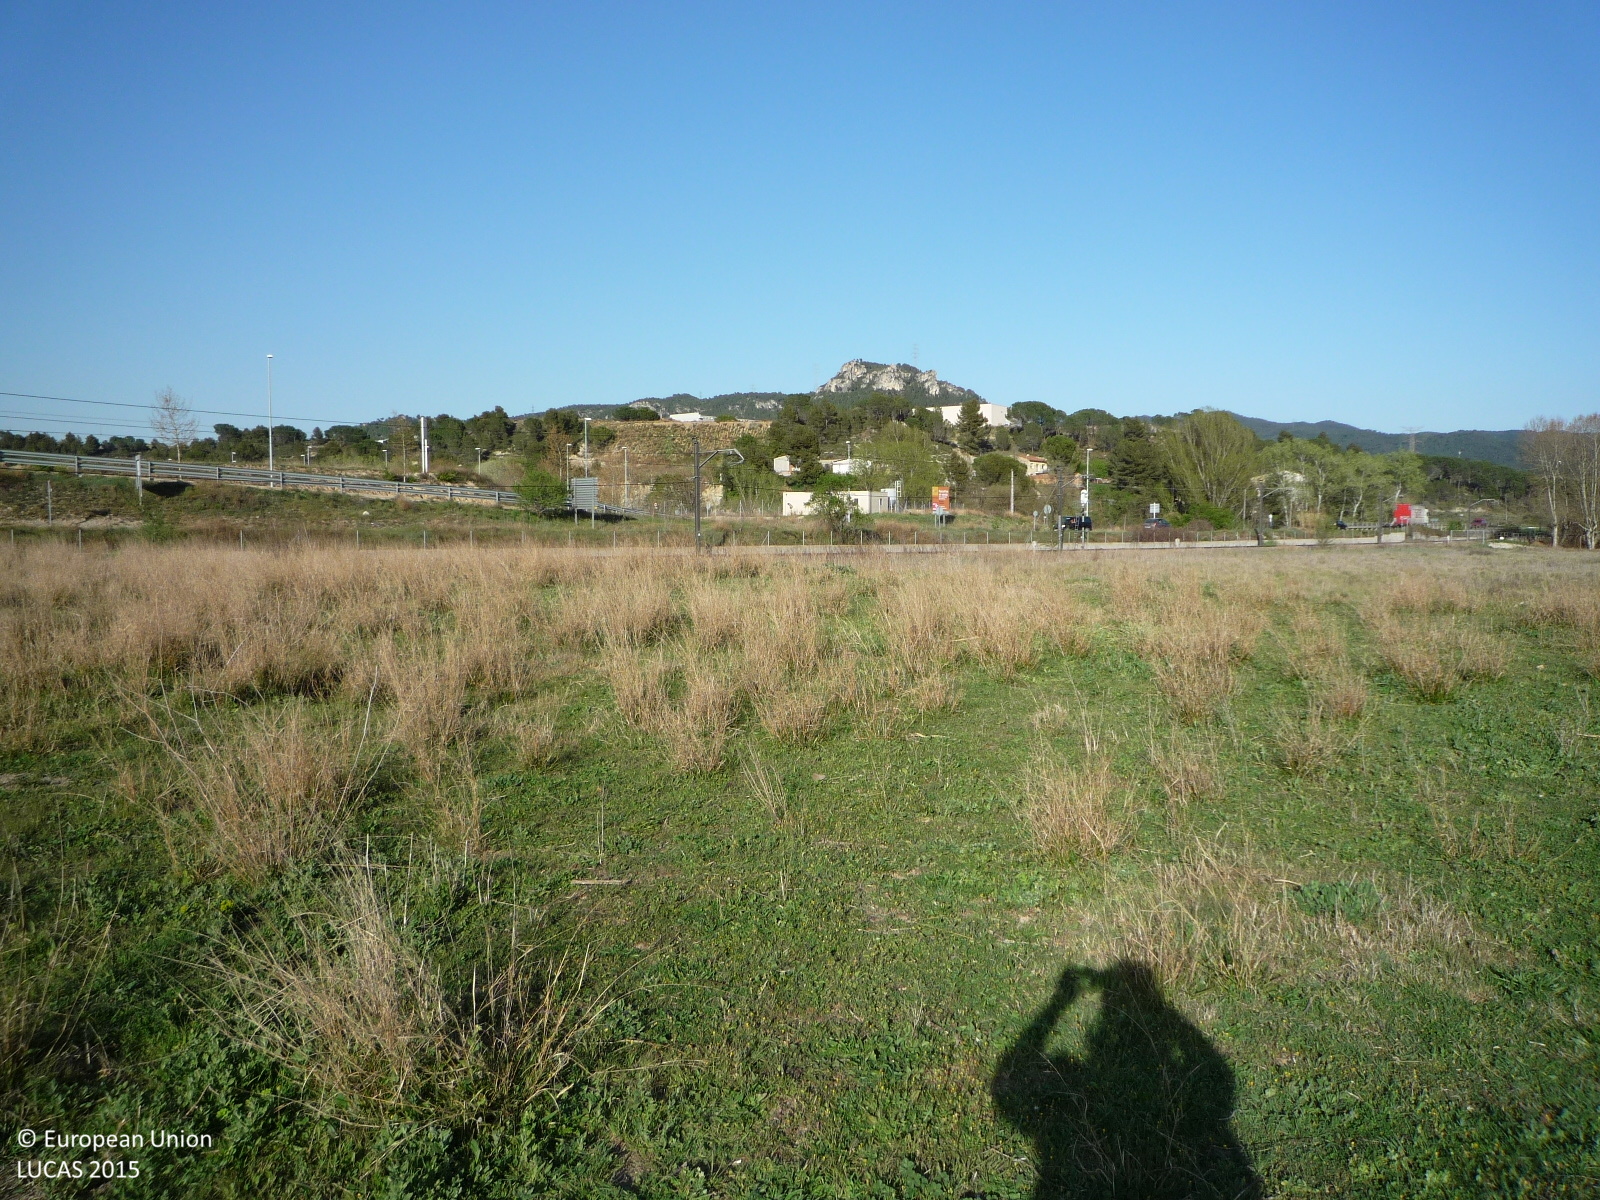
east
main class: Grassland
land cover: Grassland without tree/shrub cover
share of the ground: > 75 %
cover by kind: herbaceous plants 95 %, shrubs 5 %
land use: Abandoned areas
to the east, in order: Grassland without tree/shrub cover; Railways; Electric lines; Fences; Grass margins; Paved roads, cycling and walking lanes; Grass margins; Grassland with sparse tree/shrub cover; Tracks; Grassland without tree/shrub cover; Electric lines; Shruby margins; Rivers and streams; Other mixed woodland; Shrubland without tree cover
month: April
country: ES
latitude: 41.5651
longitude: 1.6577
